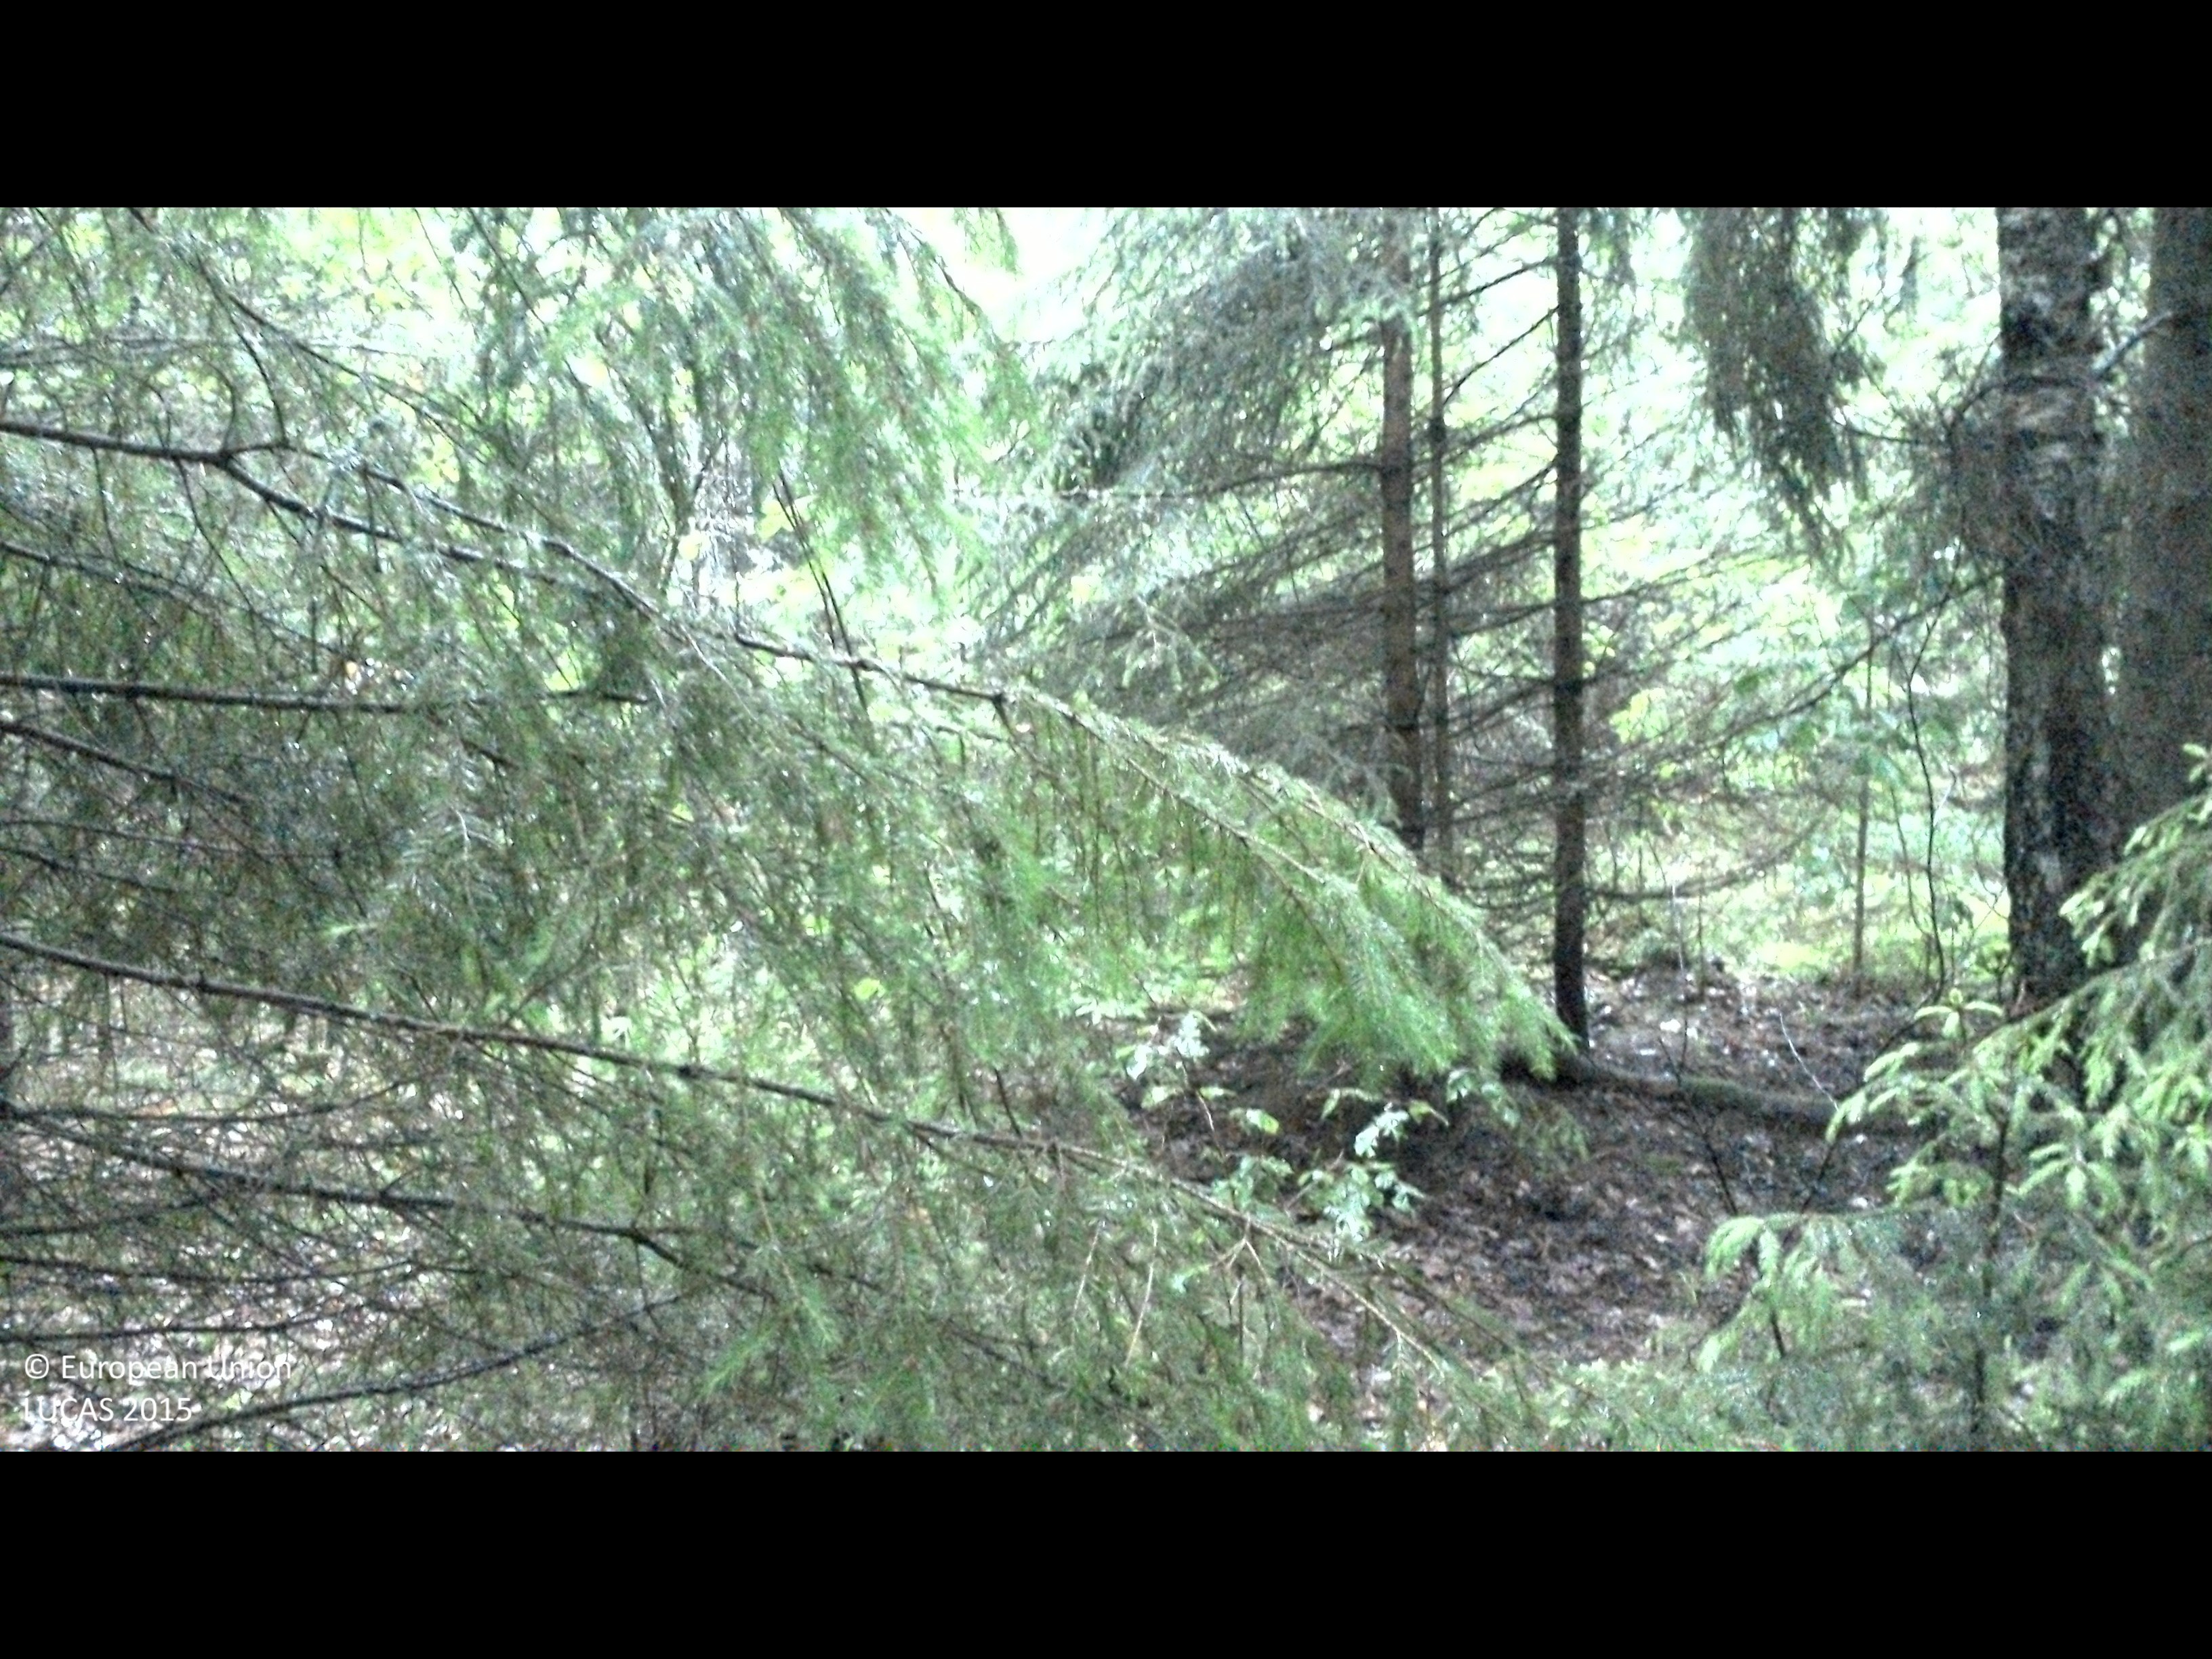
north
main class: Woodland
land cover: Spruce dominated mixed woodland
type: boreal forest
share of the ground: > 75 %
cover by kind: coniferous forest trees 50 %, broadleaved forest trees 25 %, shrubs 10 %, lichens and mosses 10 %, herbaceous plants 5 %
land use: Forestry
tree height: > 5 m
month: June
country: SE
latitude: 56.4120
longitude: 15.9160
